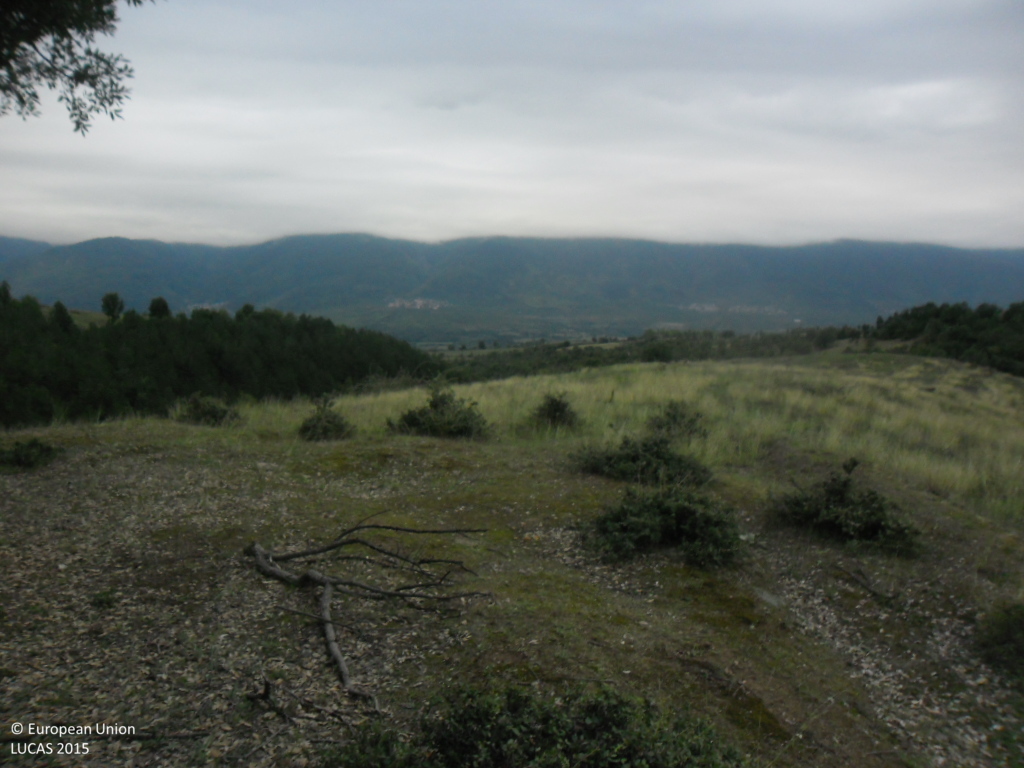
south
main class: Grassland
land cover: Grassland with sparse tree/shrub cover
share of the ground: > 75 %
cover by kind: herbaceous plants 90 %, broadleaved forest trees 5 %, shrubs 5 %
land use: Agriculture (excluding fallow land and kitchen gardens)
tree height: < 5 m
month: September
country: BG
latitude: 41.4223
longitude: 23.0474
